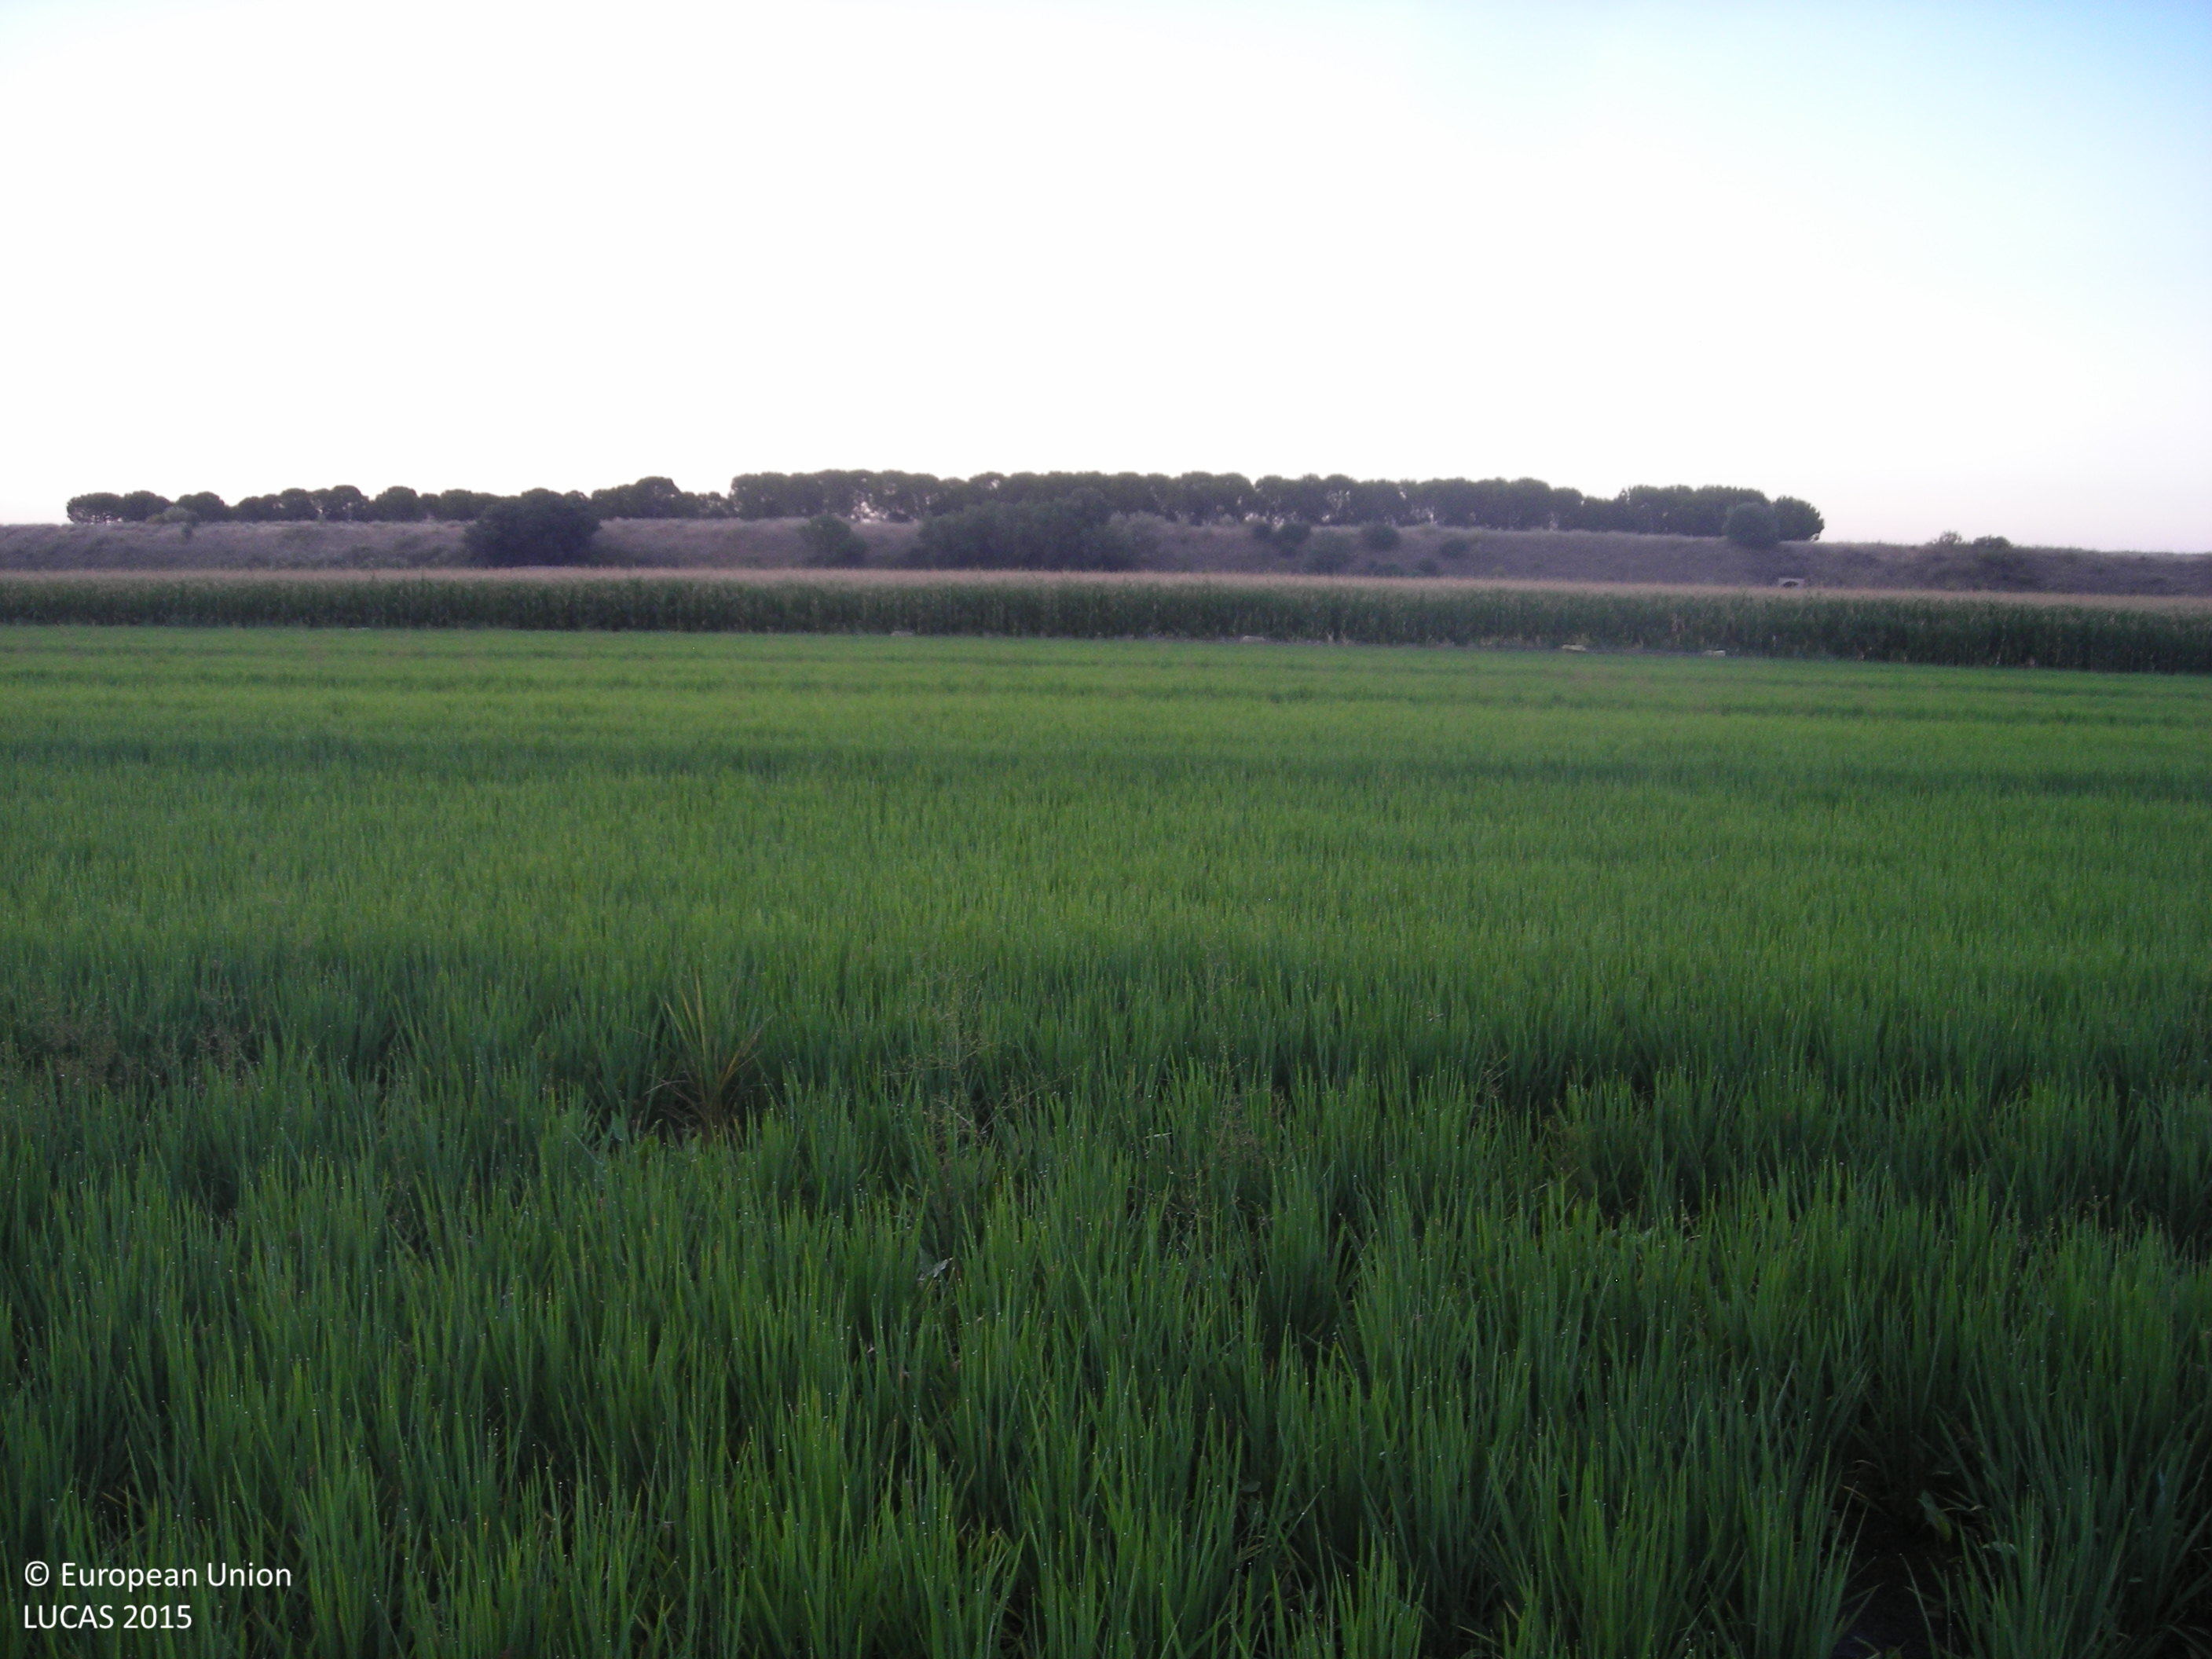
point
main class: Cropland
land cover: Rice
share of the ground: > 75 %
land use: Agriculture (excluding fallow land and kitchen gardens)
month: July
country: ES
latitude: 38.9230
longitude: -5.9092
